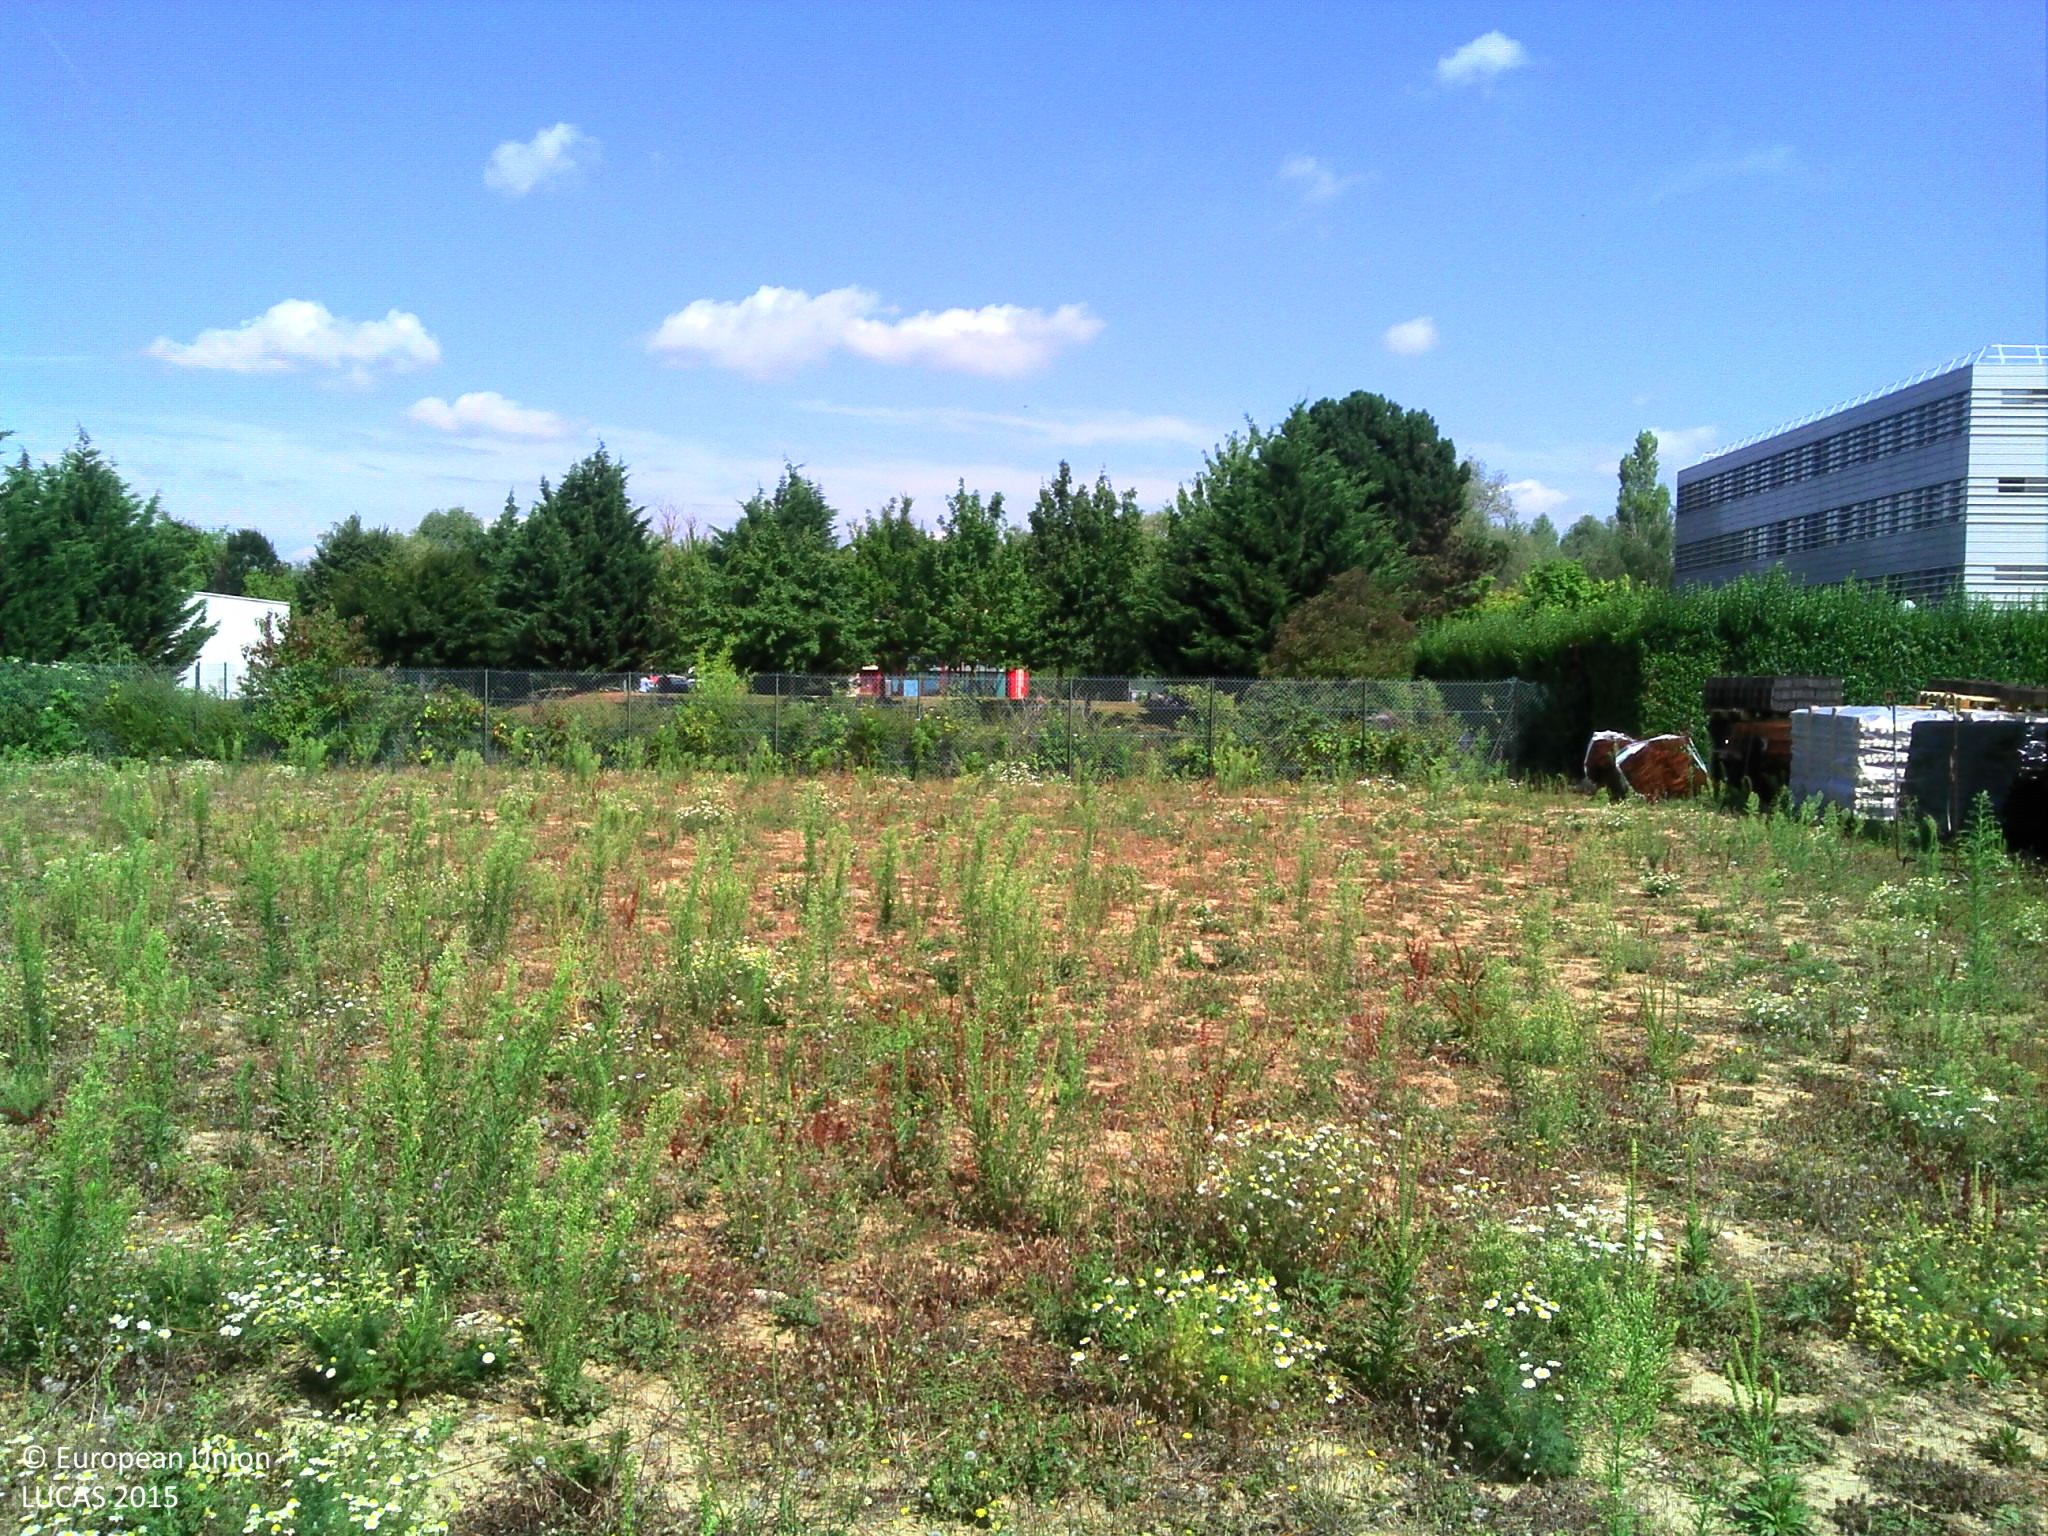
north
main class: Grassland
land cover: Spontaneously vegetated surfaces
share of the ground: > 75 %
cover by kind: herbaceous plants 90 %, consolidated bare surface 10 %
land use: Logistics and storage
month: July
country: FR
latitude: 48.6230
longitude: 2.5686
